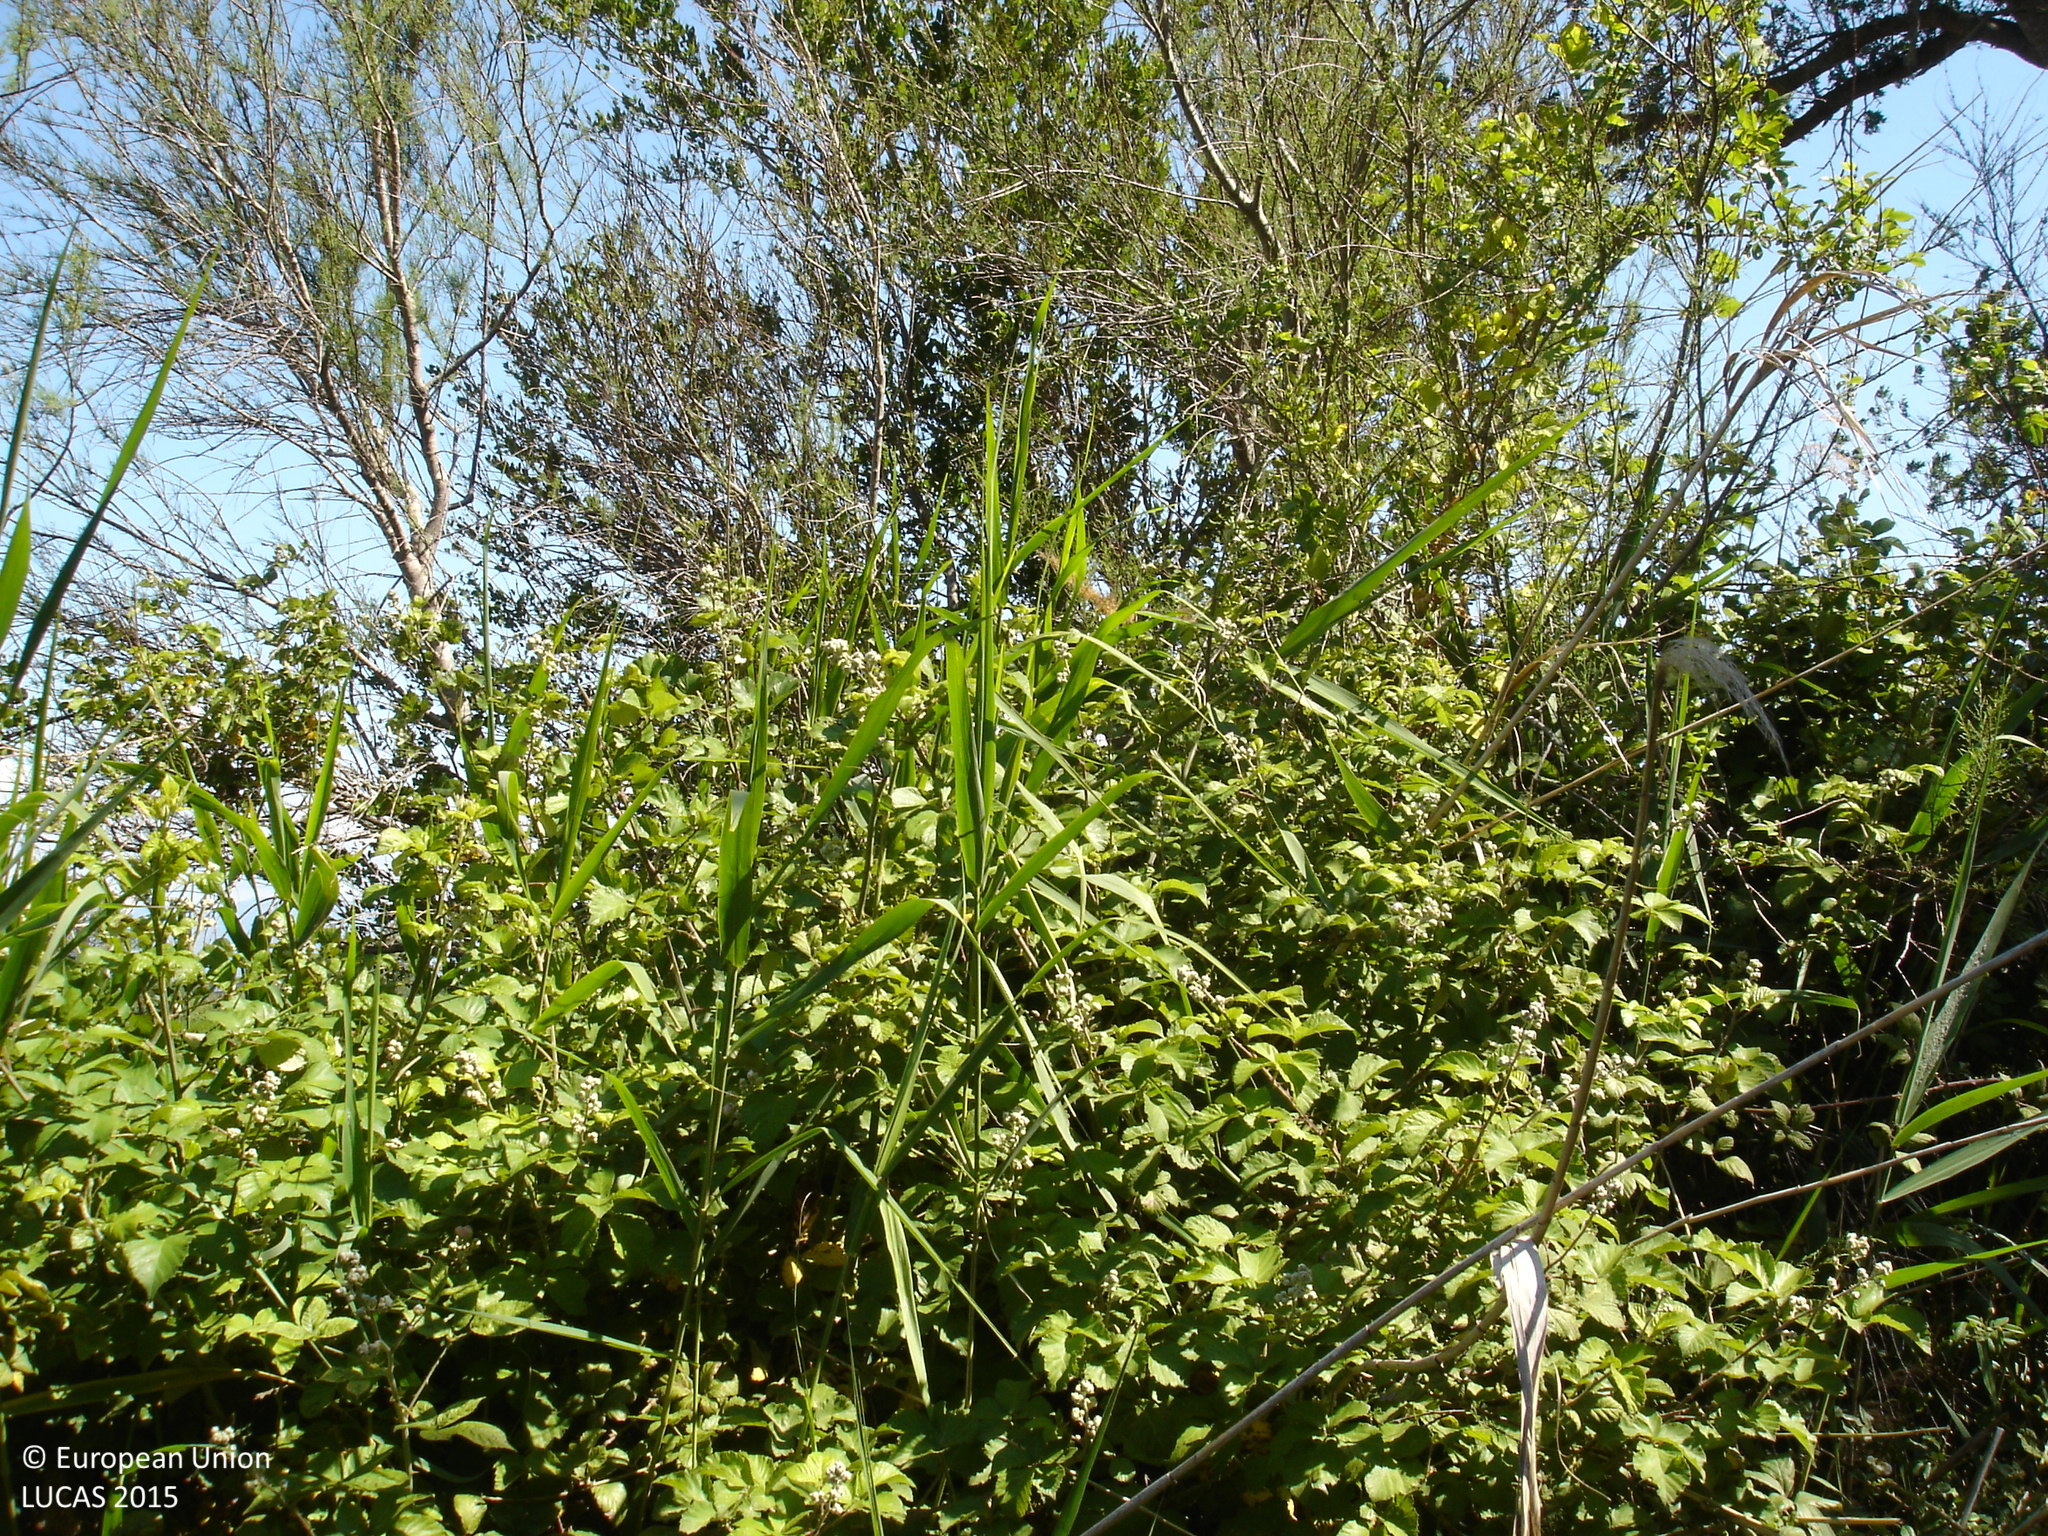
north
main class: Cropland
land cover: Maize
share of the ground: 25 - 50 %
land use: Agriculture (excluding fallow land and kitchen gardens)
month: May
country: ES
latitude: 42.2517
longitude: 3.0450
